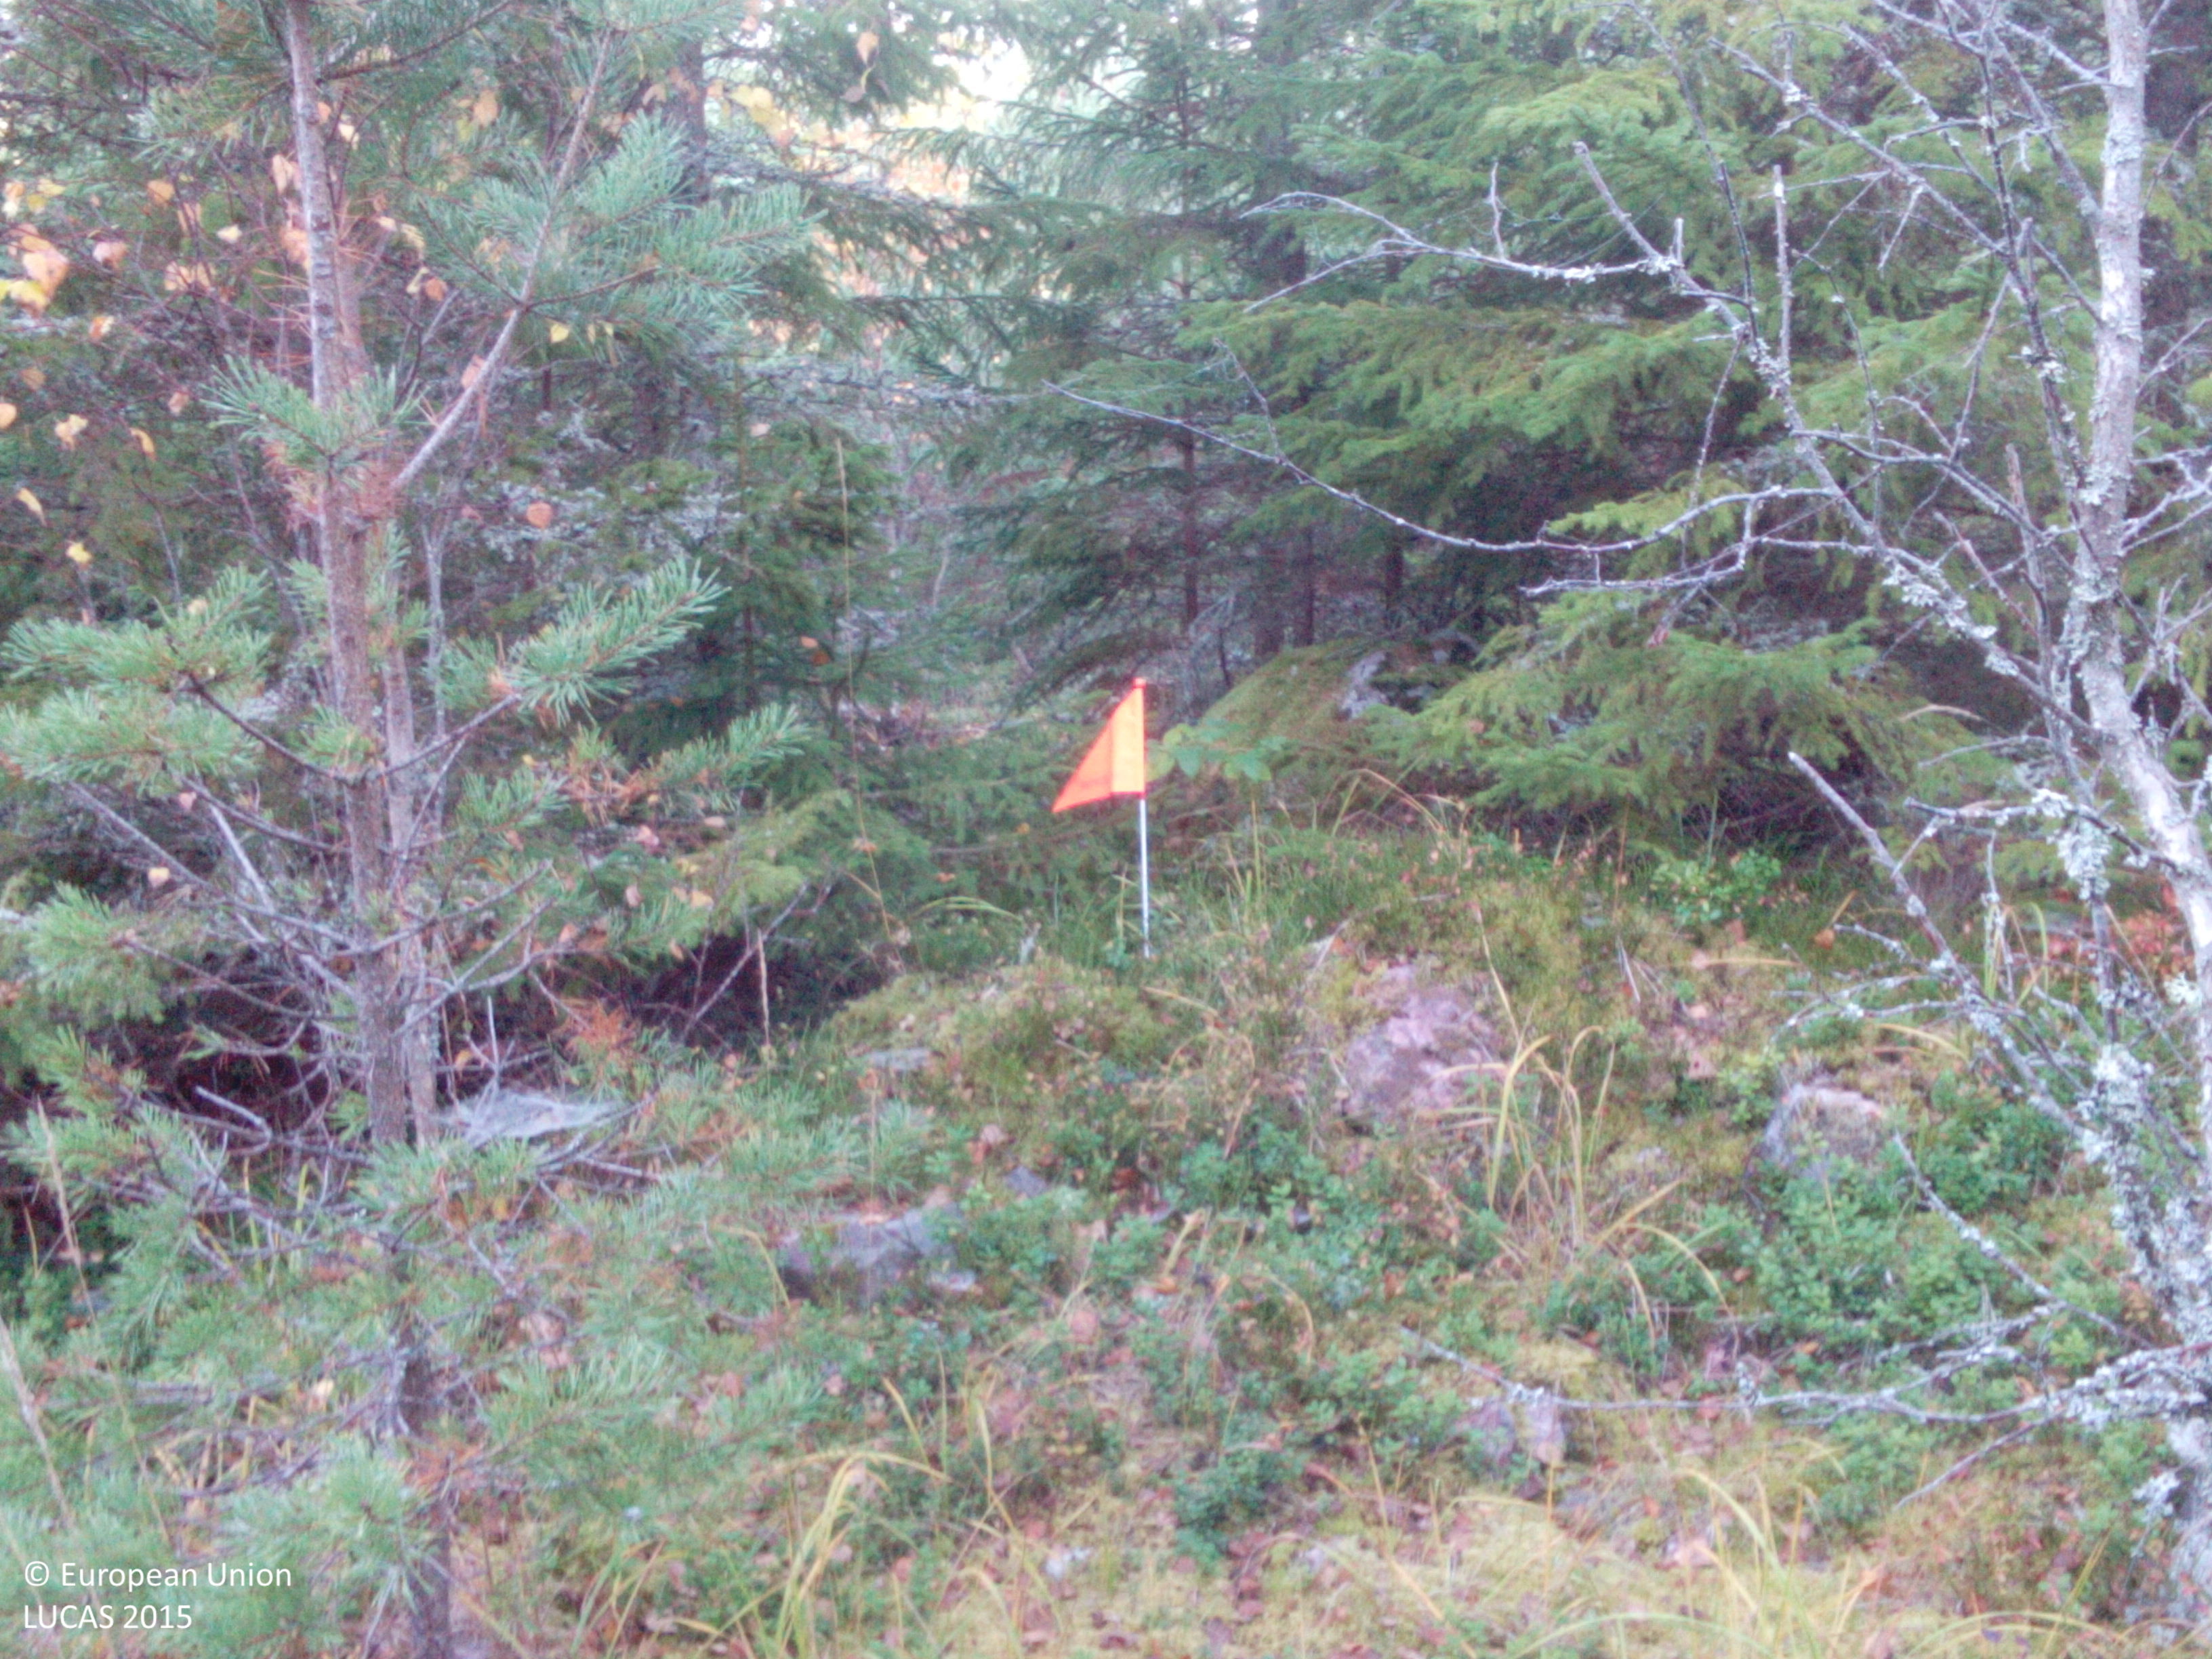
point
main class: Woodland
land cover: Spruce dominated coniferous woodland
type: boreal forest
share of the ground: > 75 %
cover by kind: coniferous forest trees 70 %, lichens and mosses 20 %, broadleaved forest trees 10 %
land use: Forestry
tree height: > 5 m
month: October
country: SE
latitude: 59.1205
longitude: 16.2646
